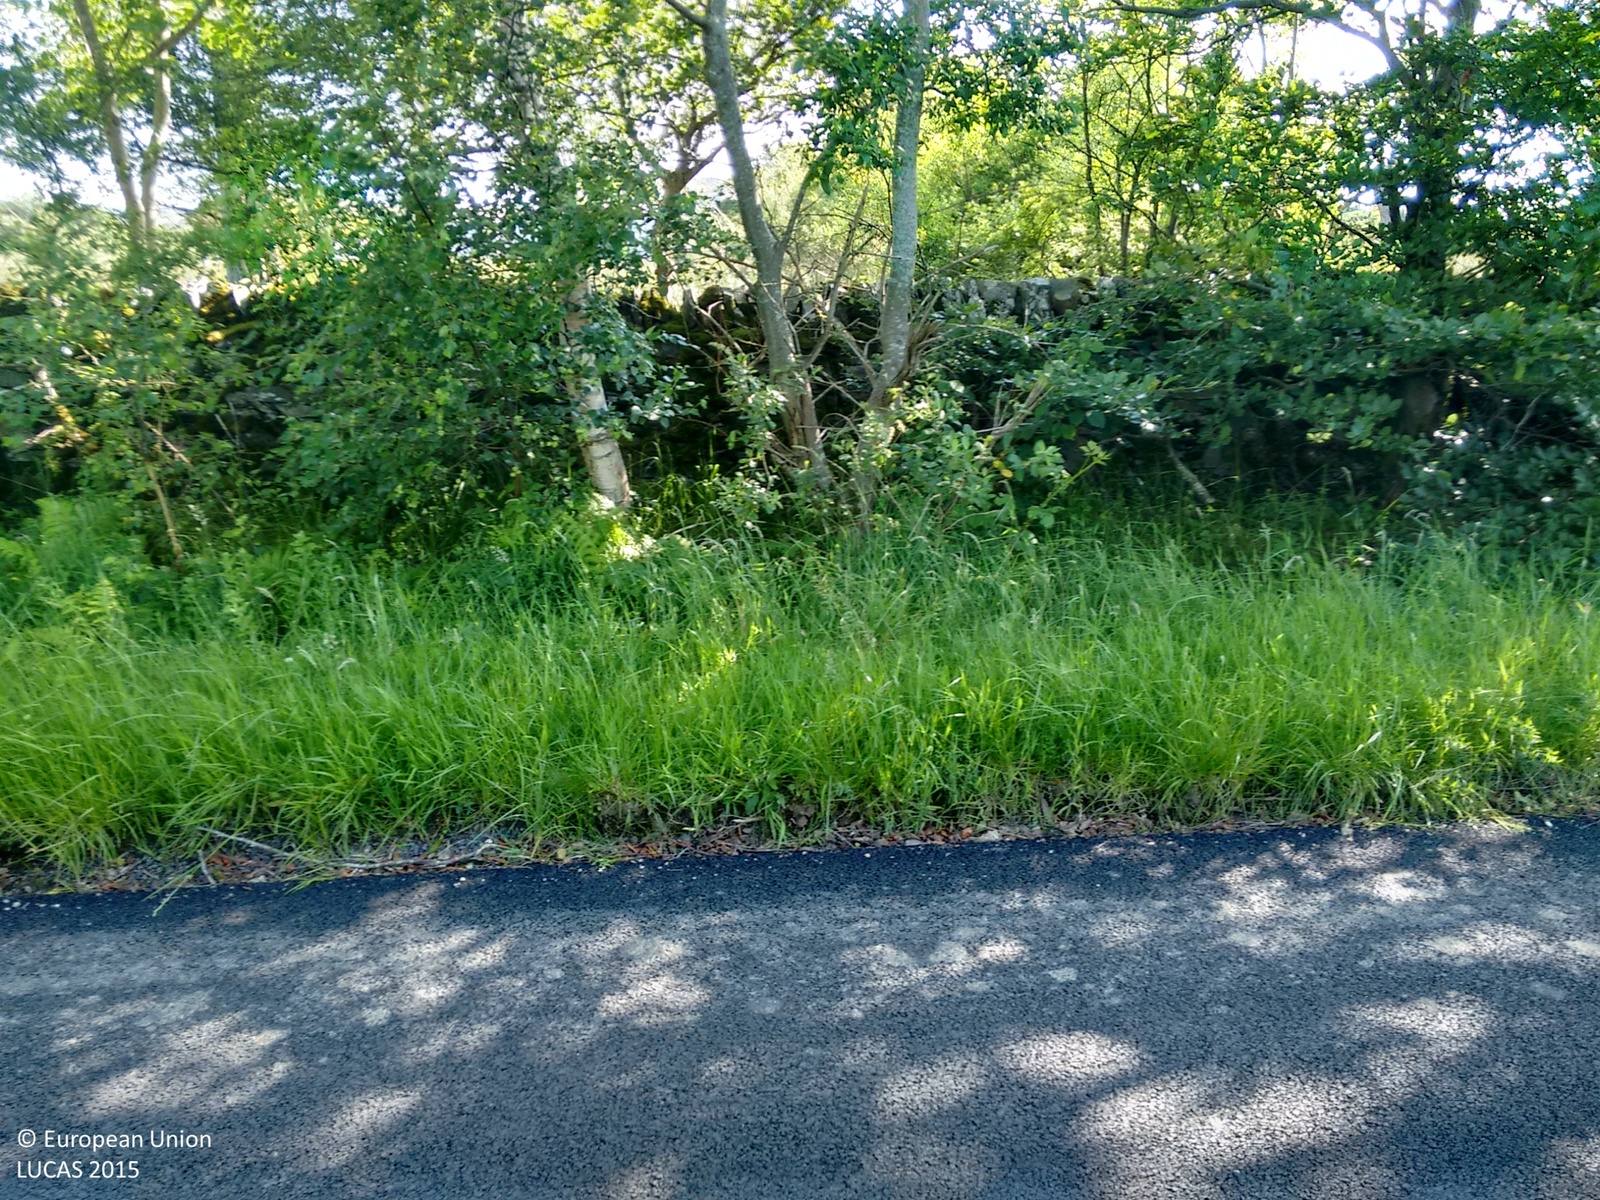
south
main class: Grassland
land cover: Grassland without tree/shrub cover
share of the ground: > 75 %
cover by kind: herbaceous plants 100 %
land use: Agriculture (excluding fallow land and kitchen gardens)
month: July
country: GB
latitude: 55.8396
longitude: -5.0749
